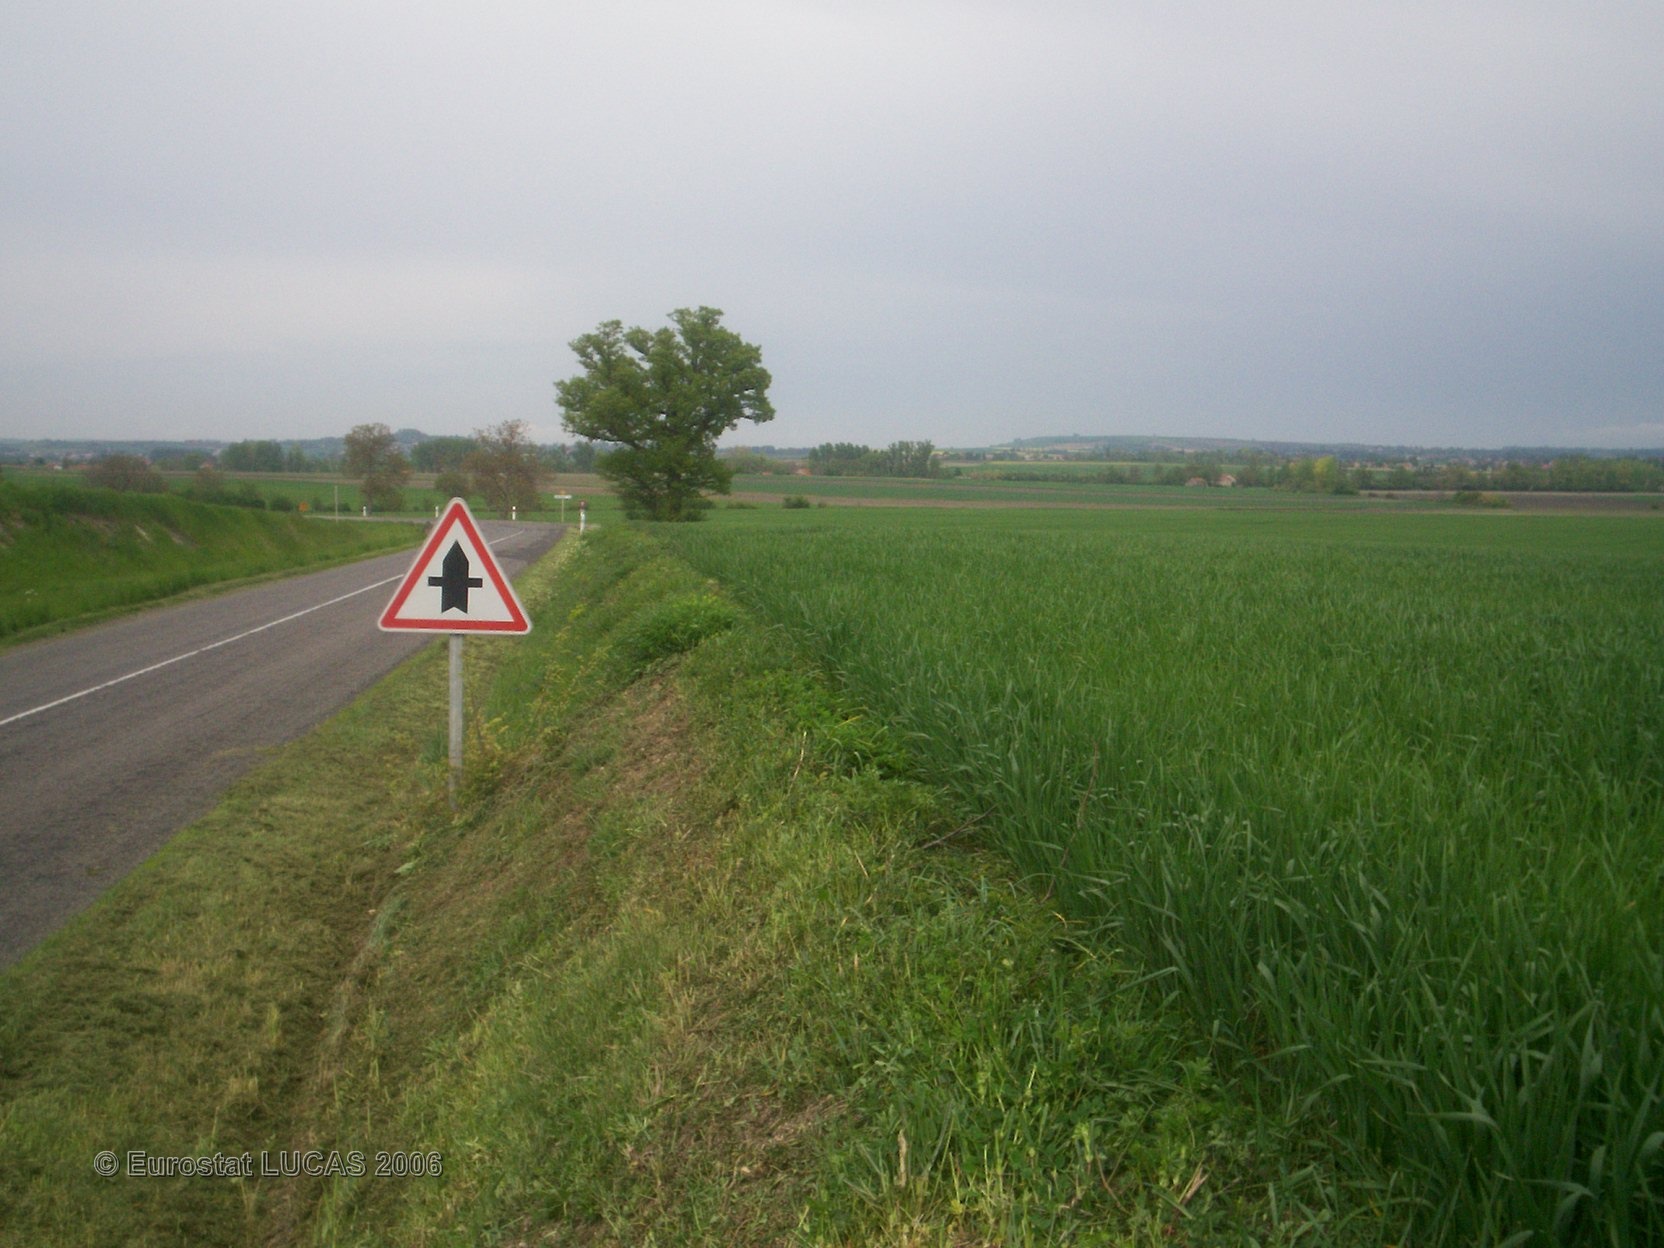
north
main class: Cropland
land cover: Common wheat
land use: Agriculture (excluding fallow land and kitchen gardens)
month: May
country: FR
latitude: 45.9931
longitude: 3.2472
